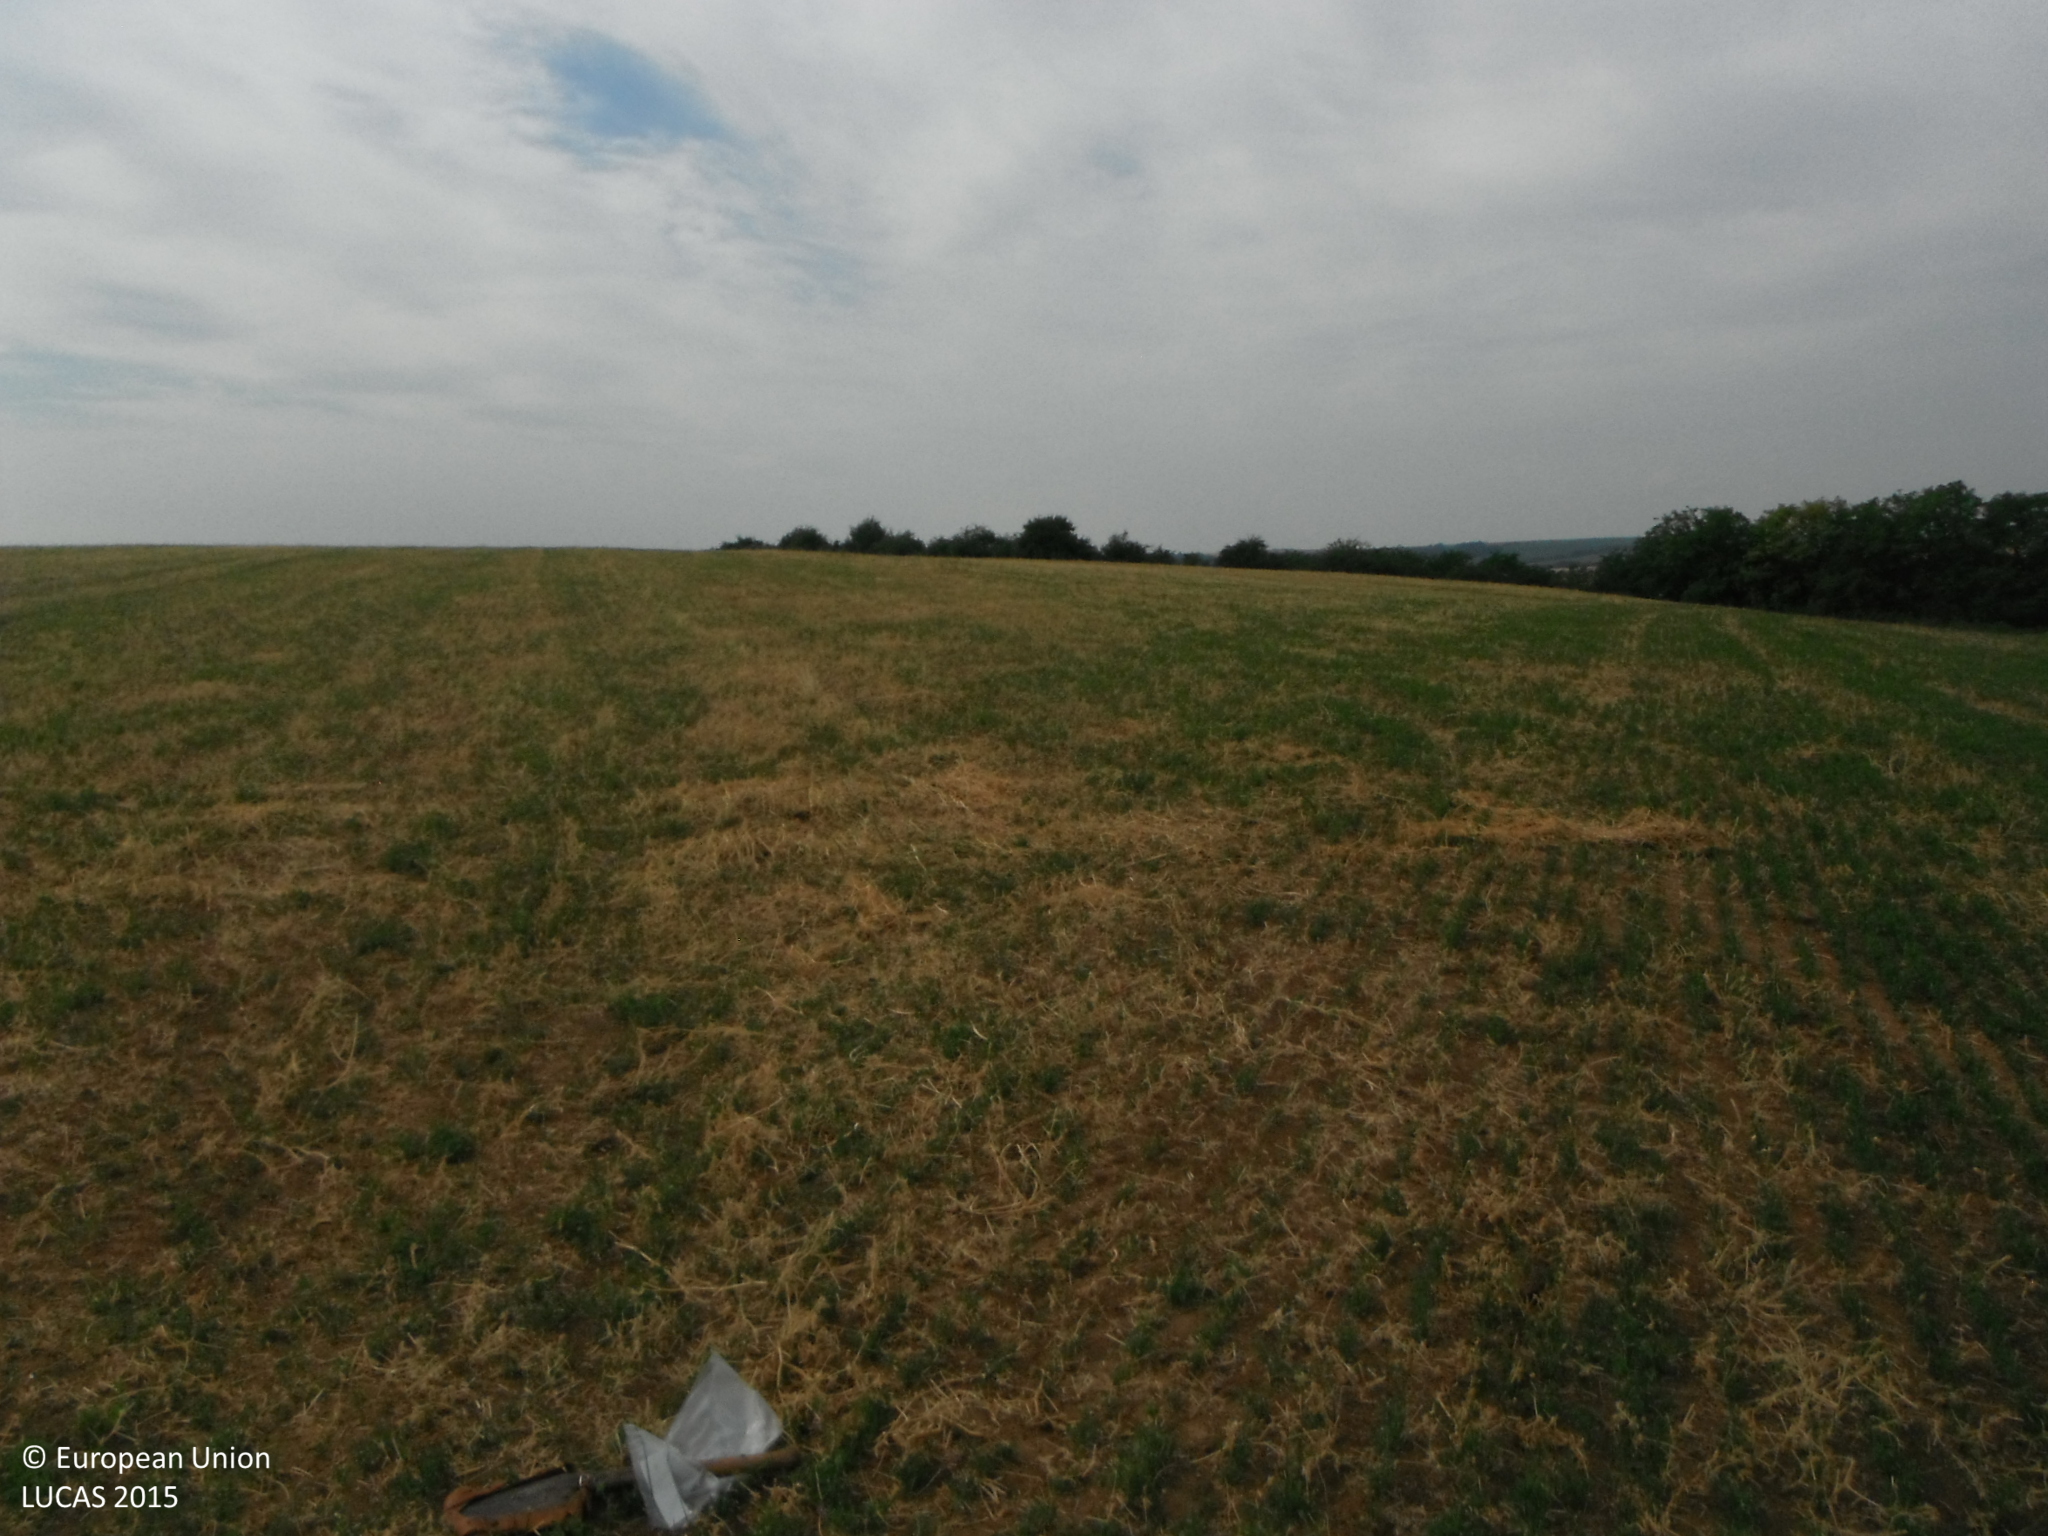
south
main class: Cropland
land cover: Dry pulses
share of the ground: < 10 %
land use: Agriculture (excluding fallow land and kitchen gardens)
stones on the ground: < 10 %
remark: Harvested field
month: June
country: SK
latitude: 48.3806
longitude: 17.8027
